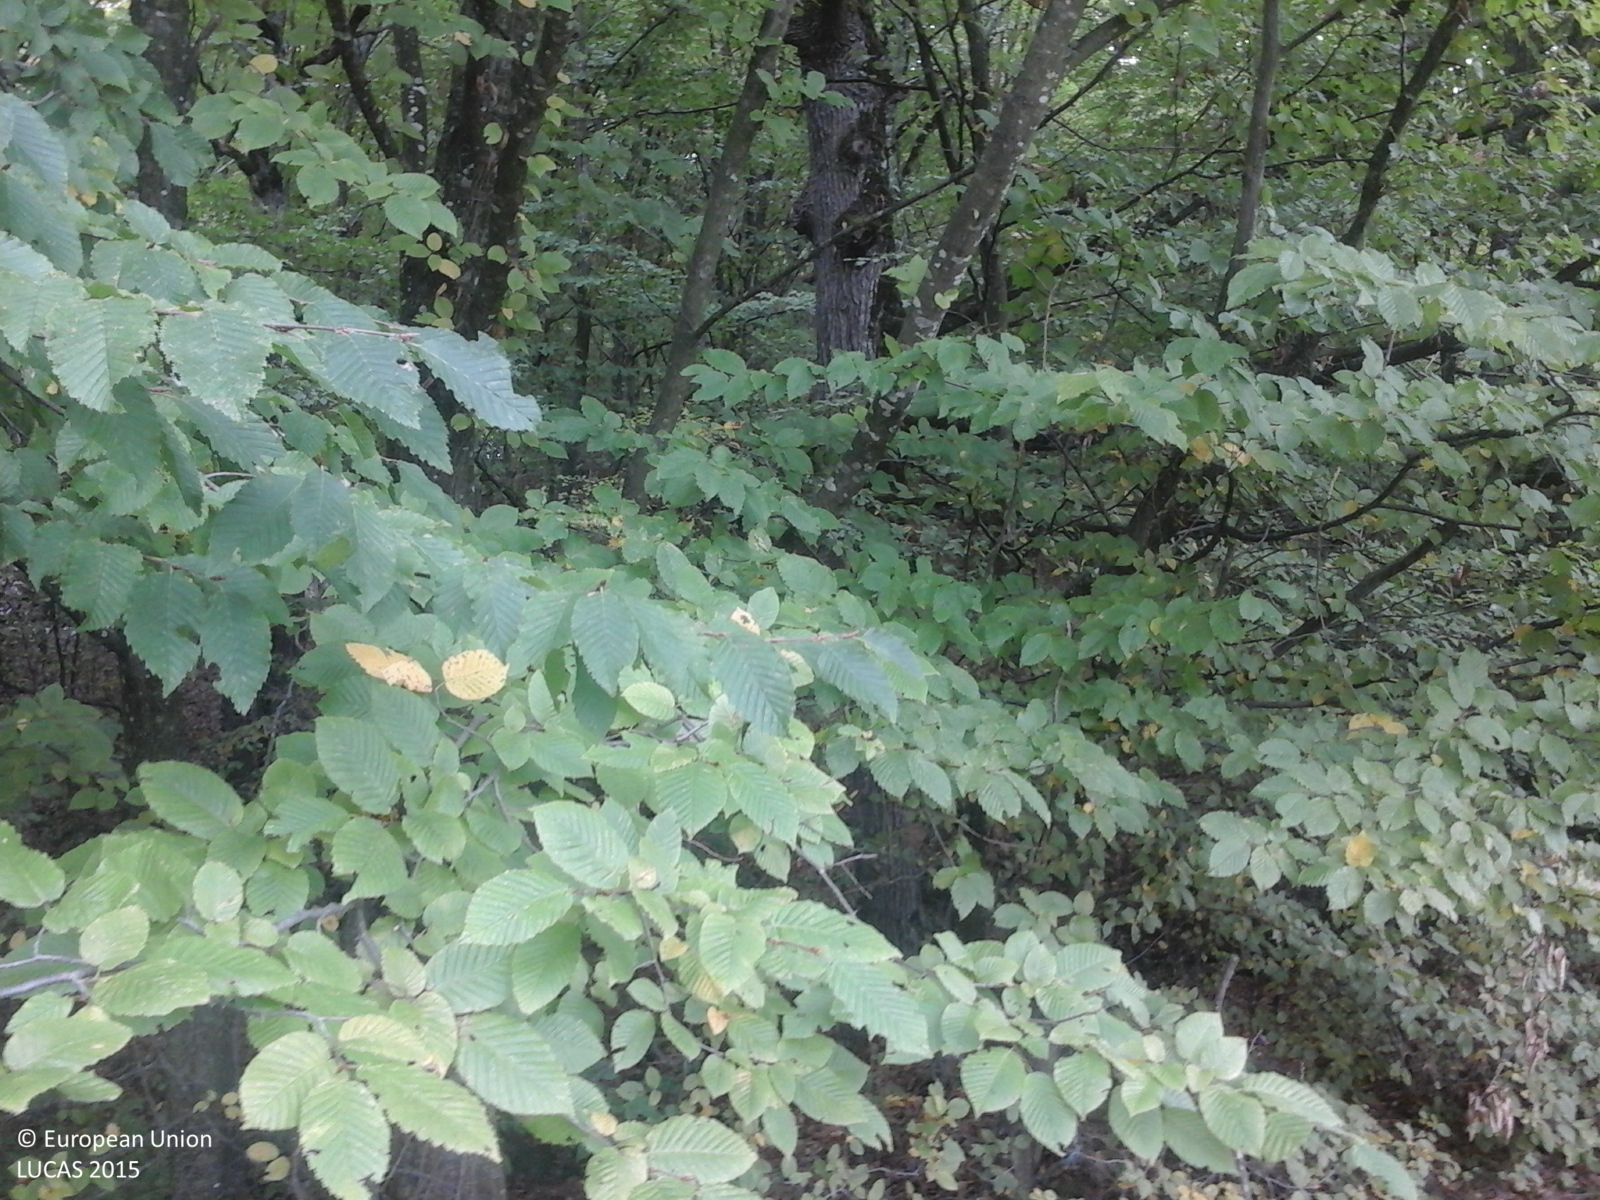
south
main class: Woodland
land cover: Broadleaved woodland
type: beech forest
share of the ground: > 75 %
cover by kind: broadleaved forest trees 100 %
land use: Forestry
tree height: > 5 m
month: October
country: RO
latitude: 45.9522
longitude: 25.2053
